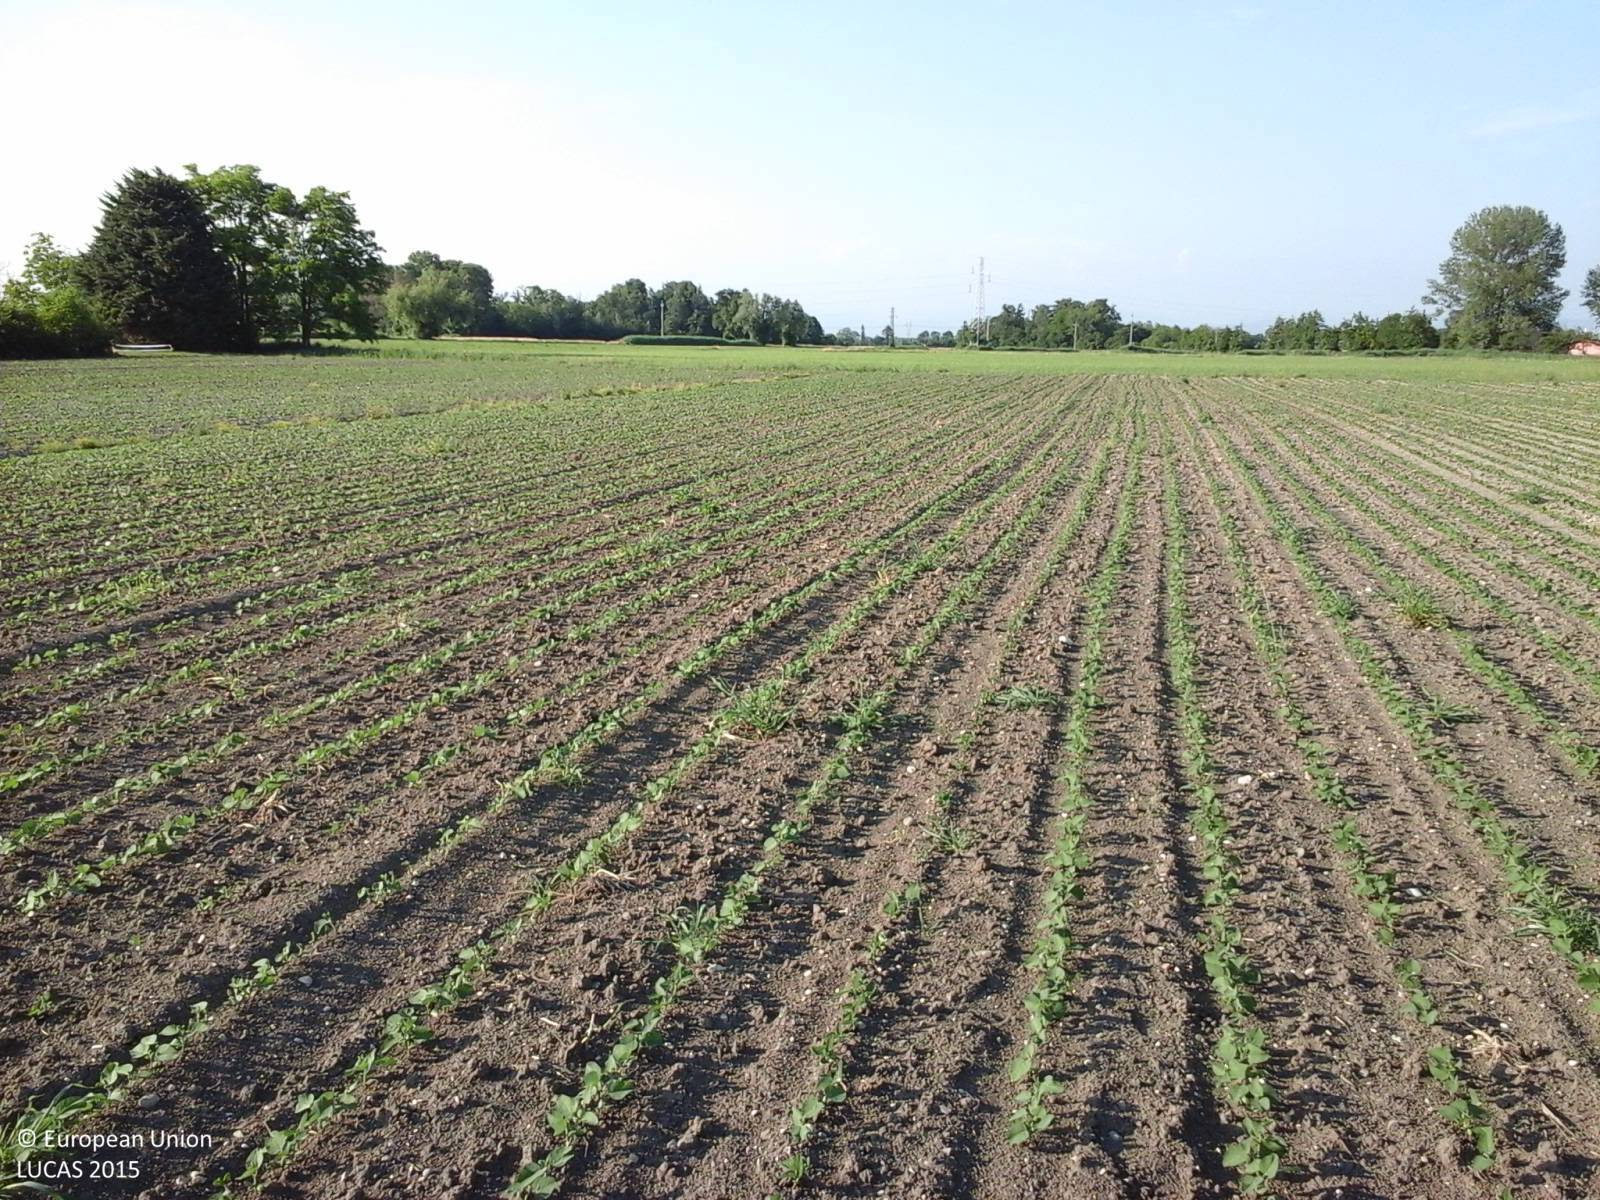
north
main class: Cropland
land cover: Soya
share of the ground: 25 - 50 %
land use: Agriculture (excluding fallow land and kitchen gardens)
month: June
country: IT
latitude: 45.8494
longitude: 13.3056
